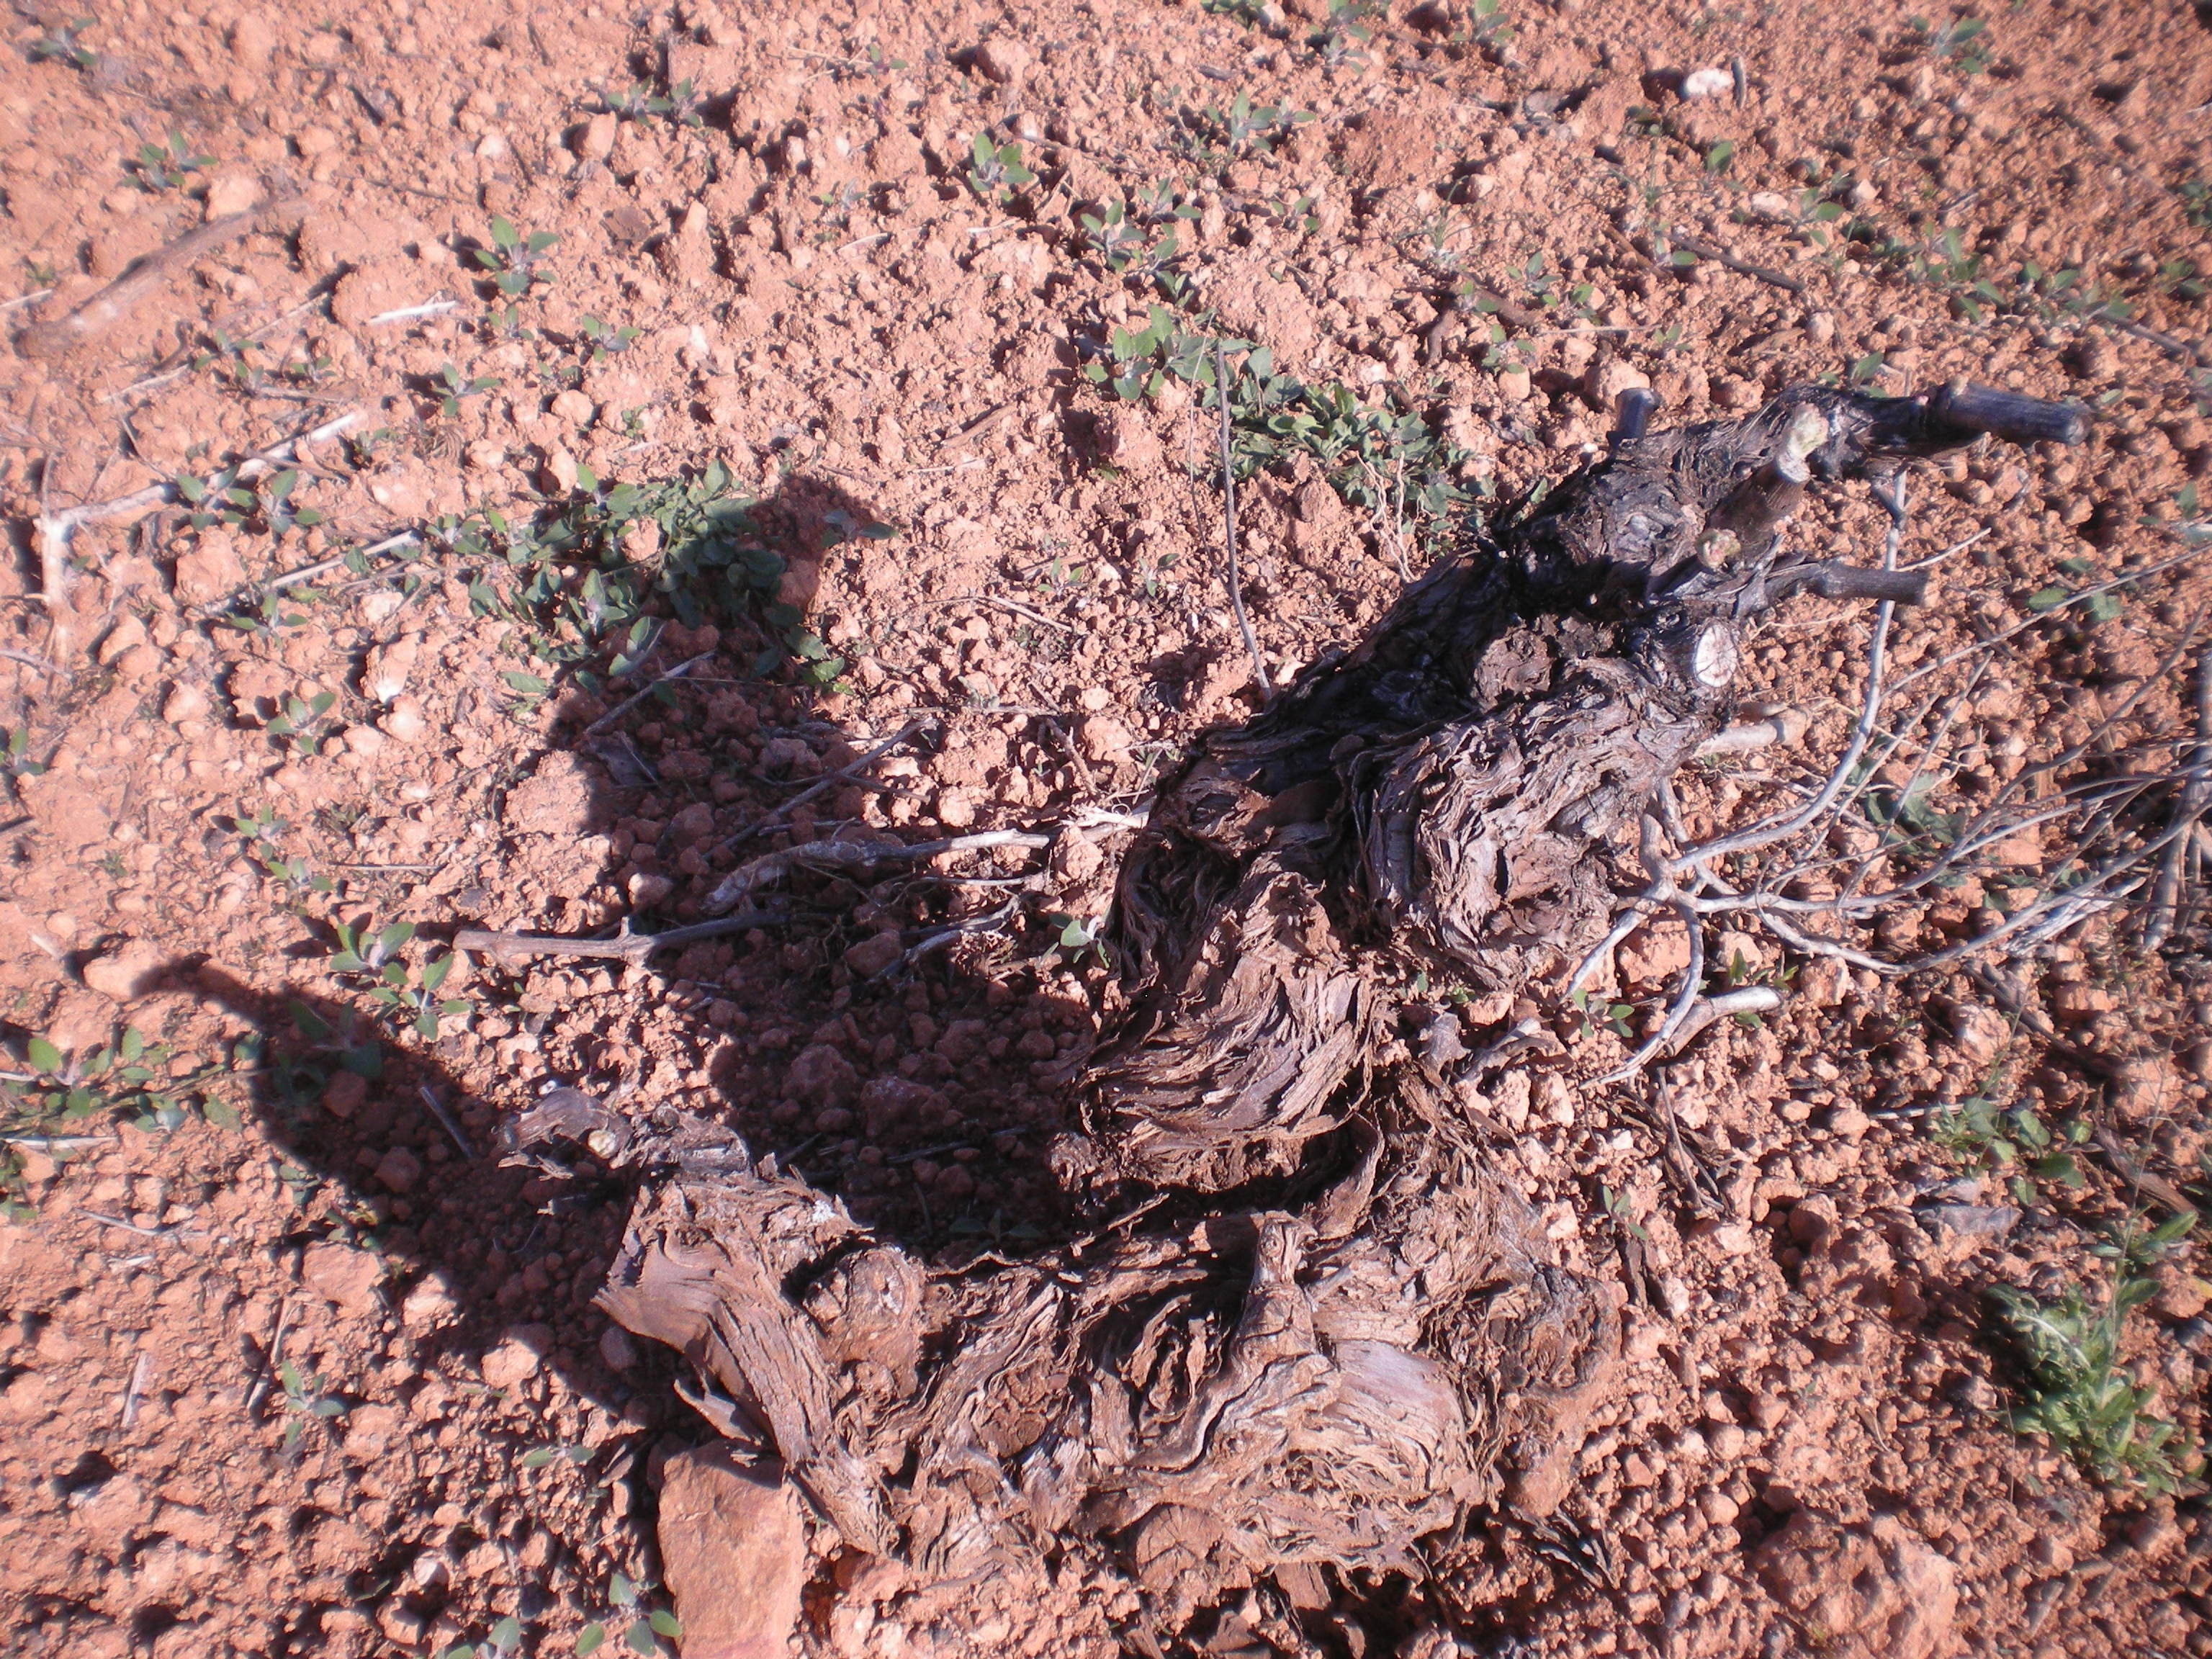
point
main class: Cropland
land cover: Vineyards
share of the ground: < 10 %
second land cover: Other bare soil
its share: > 75 %
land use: Agriculture (excluding fallow land and kitchen gardens)
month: April
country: ES
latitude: 38.7863
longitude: -3.1907
